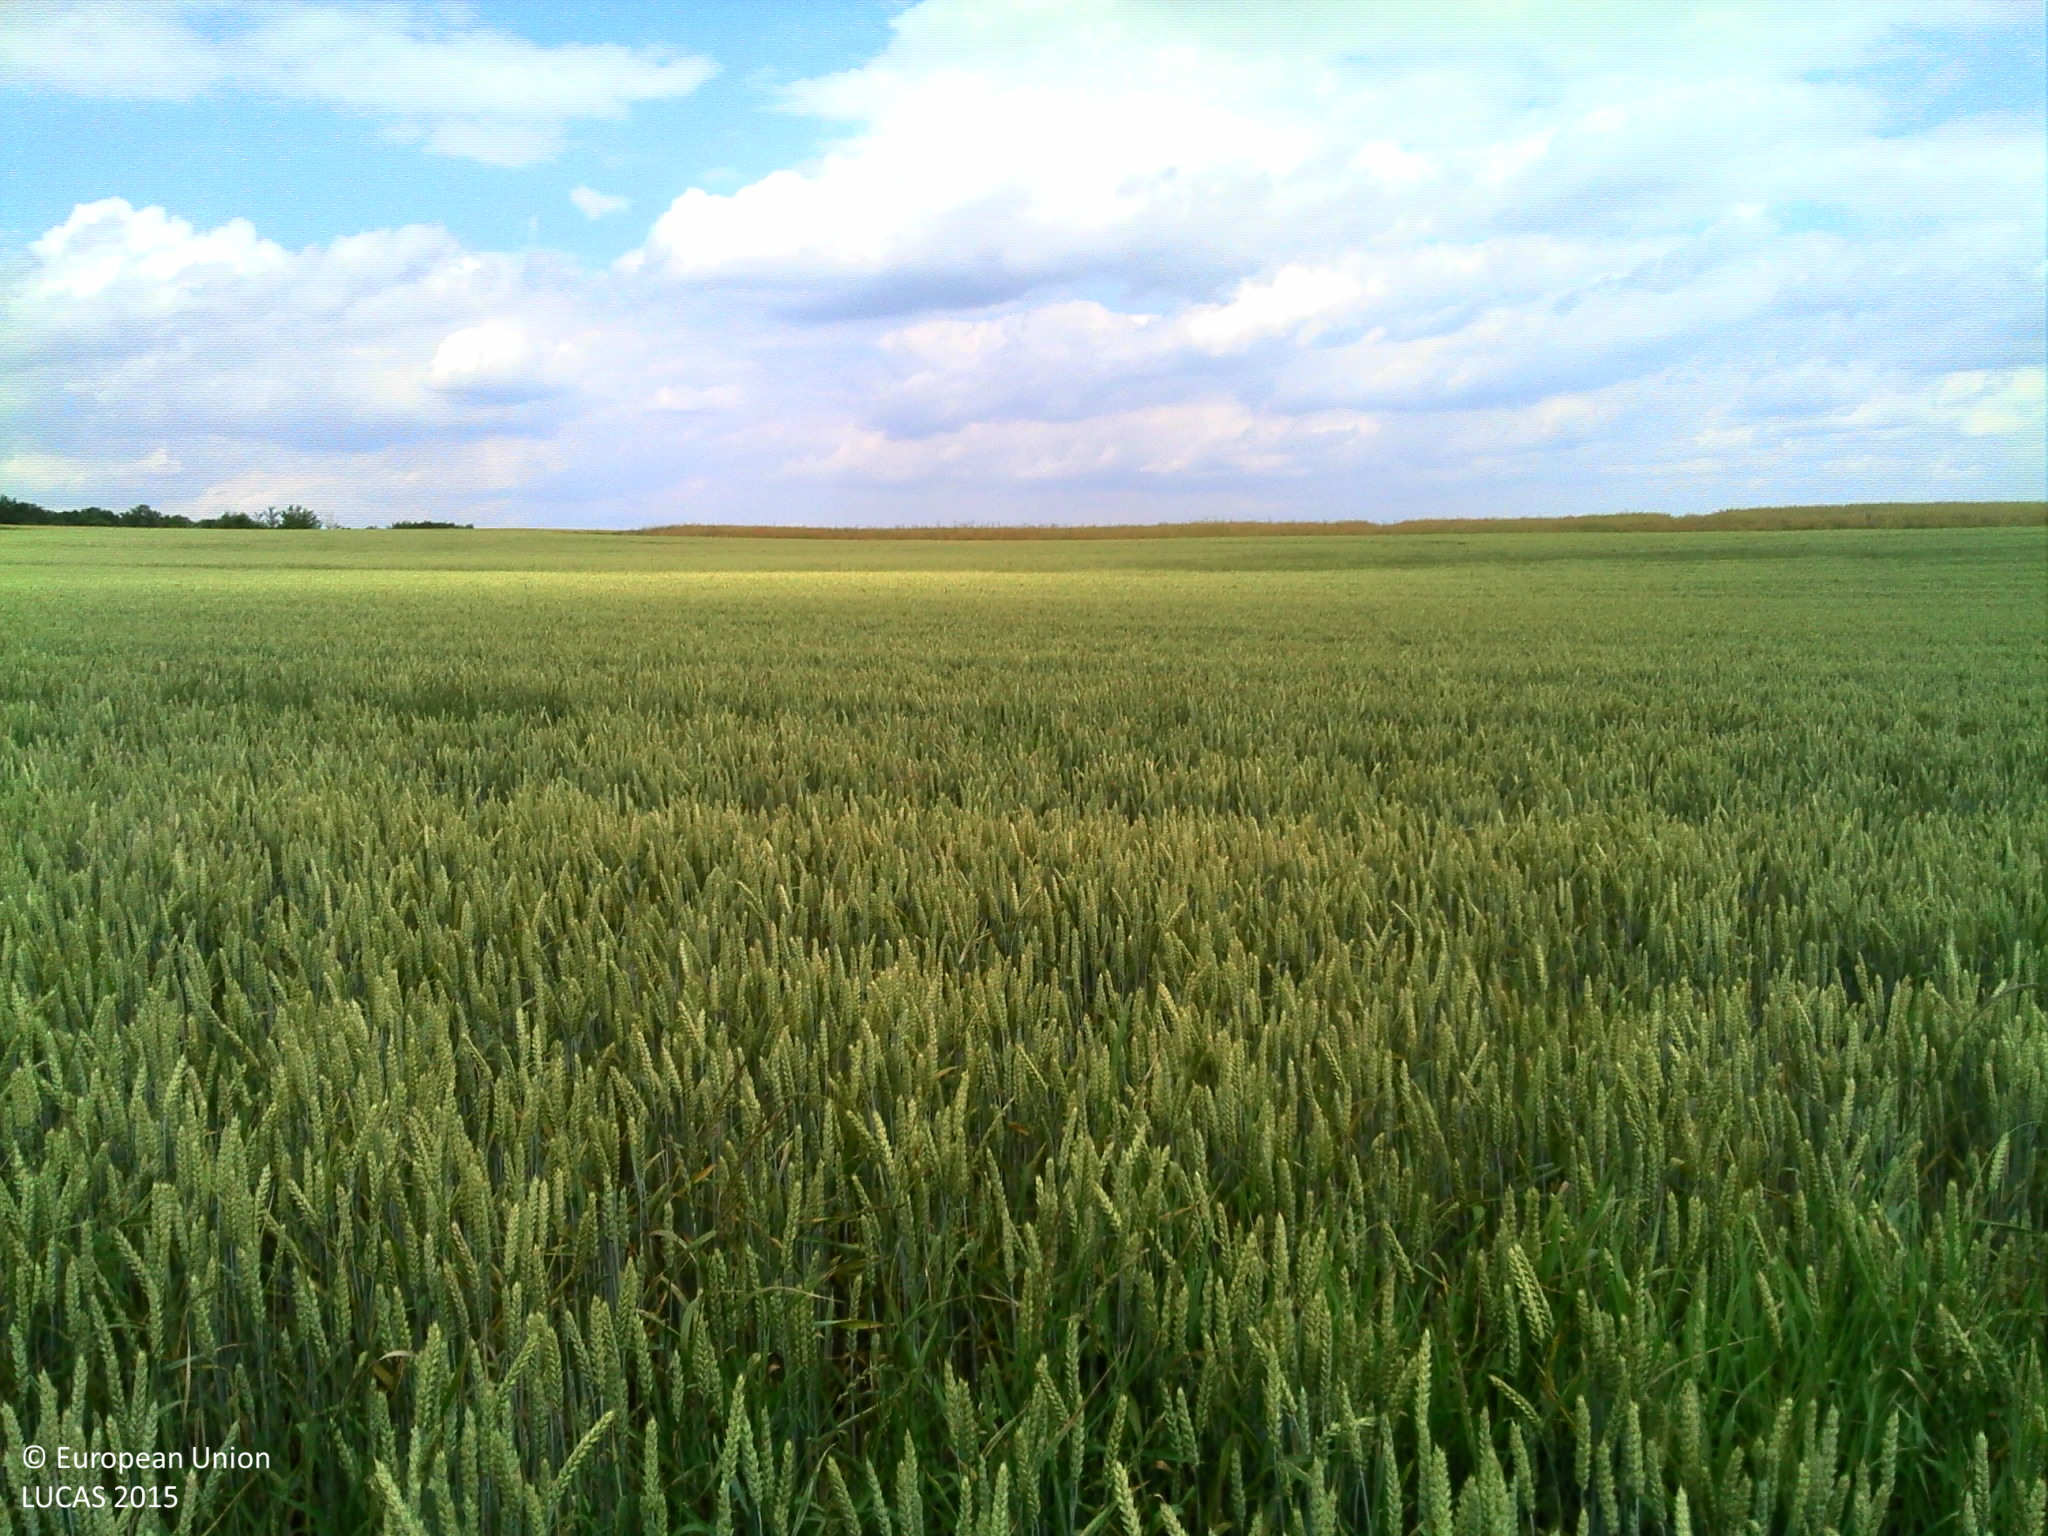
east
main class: Cropland
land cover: Common wheat
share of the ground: > 75 %
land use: Agriculture (excluding fallow land and kitchen gardens)
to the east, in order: Common wheat; Grass margins; Common wheat
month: June
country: FR
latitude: 47.4481
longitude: 3.1118
